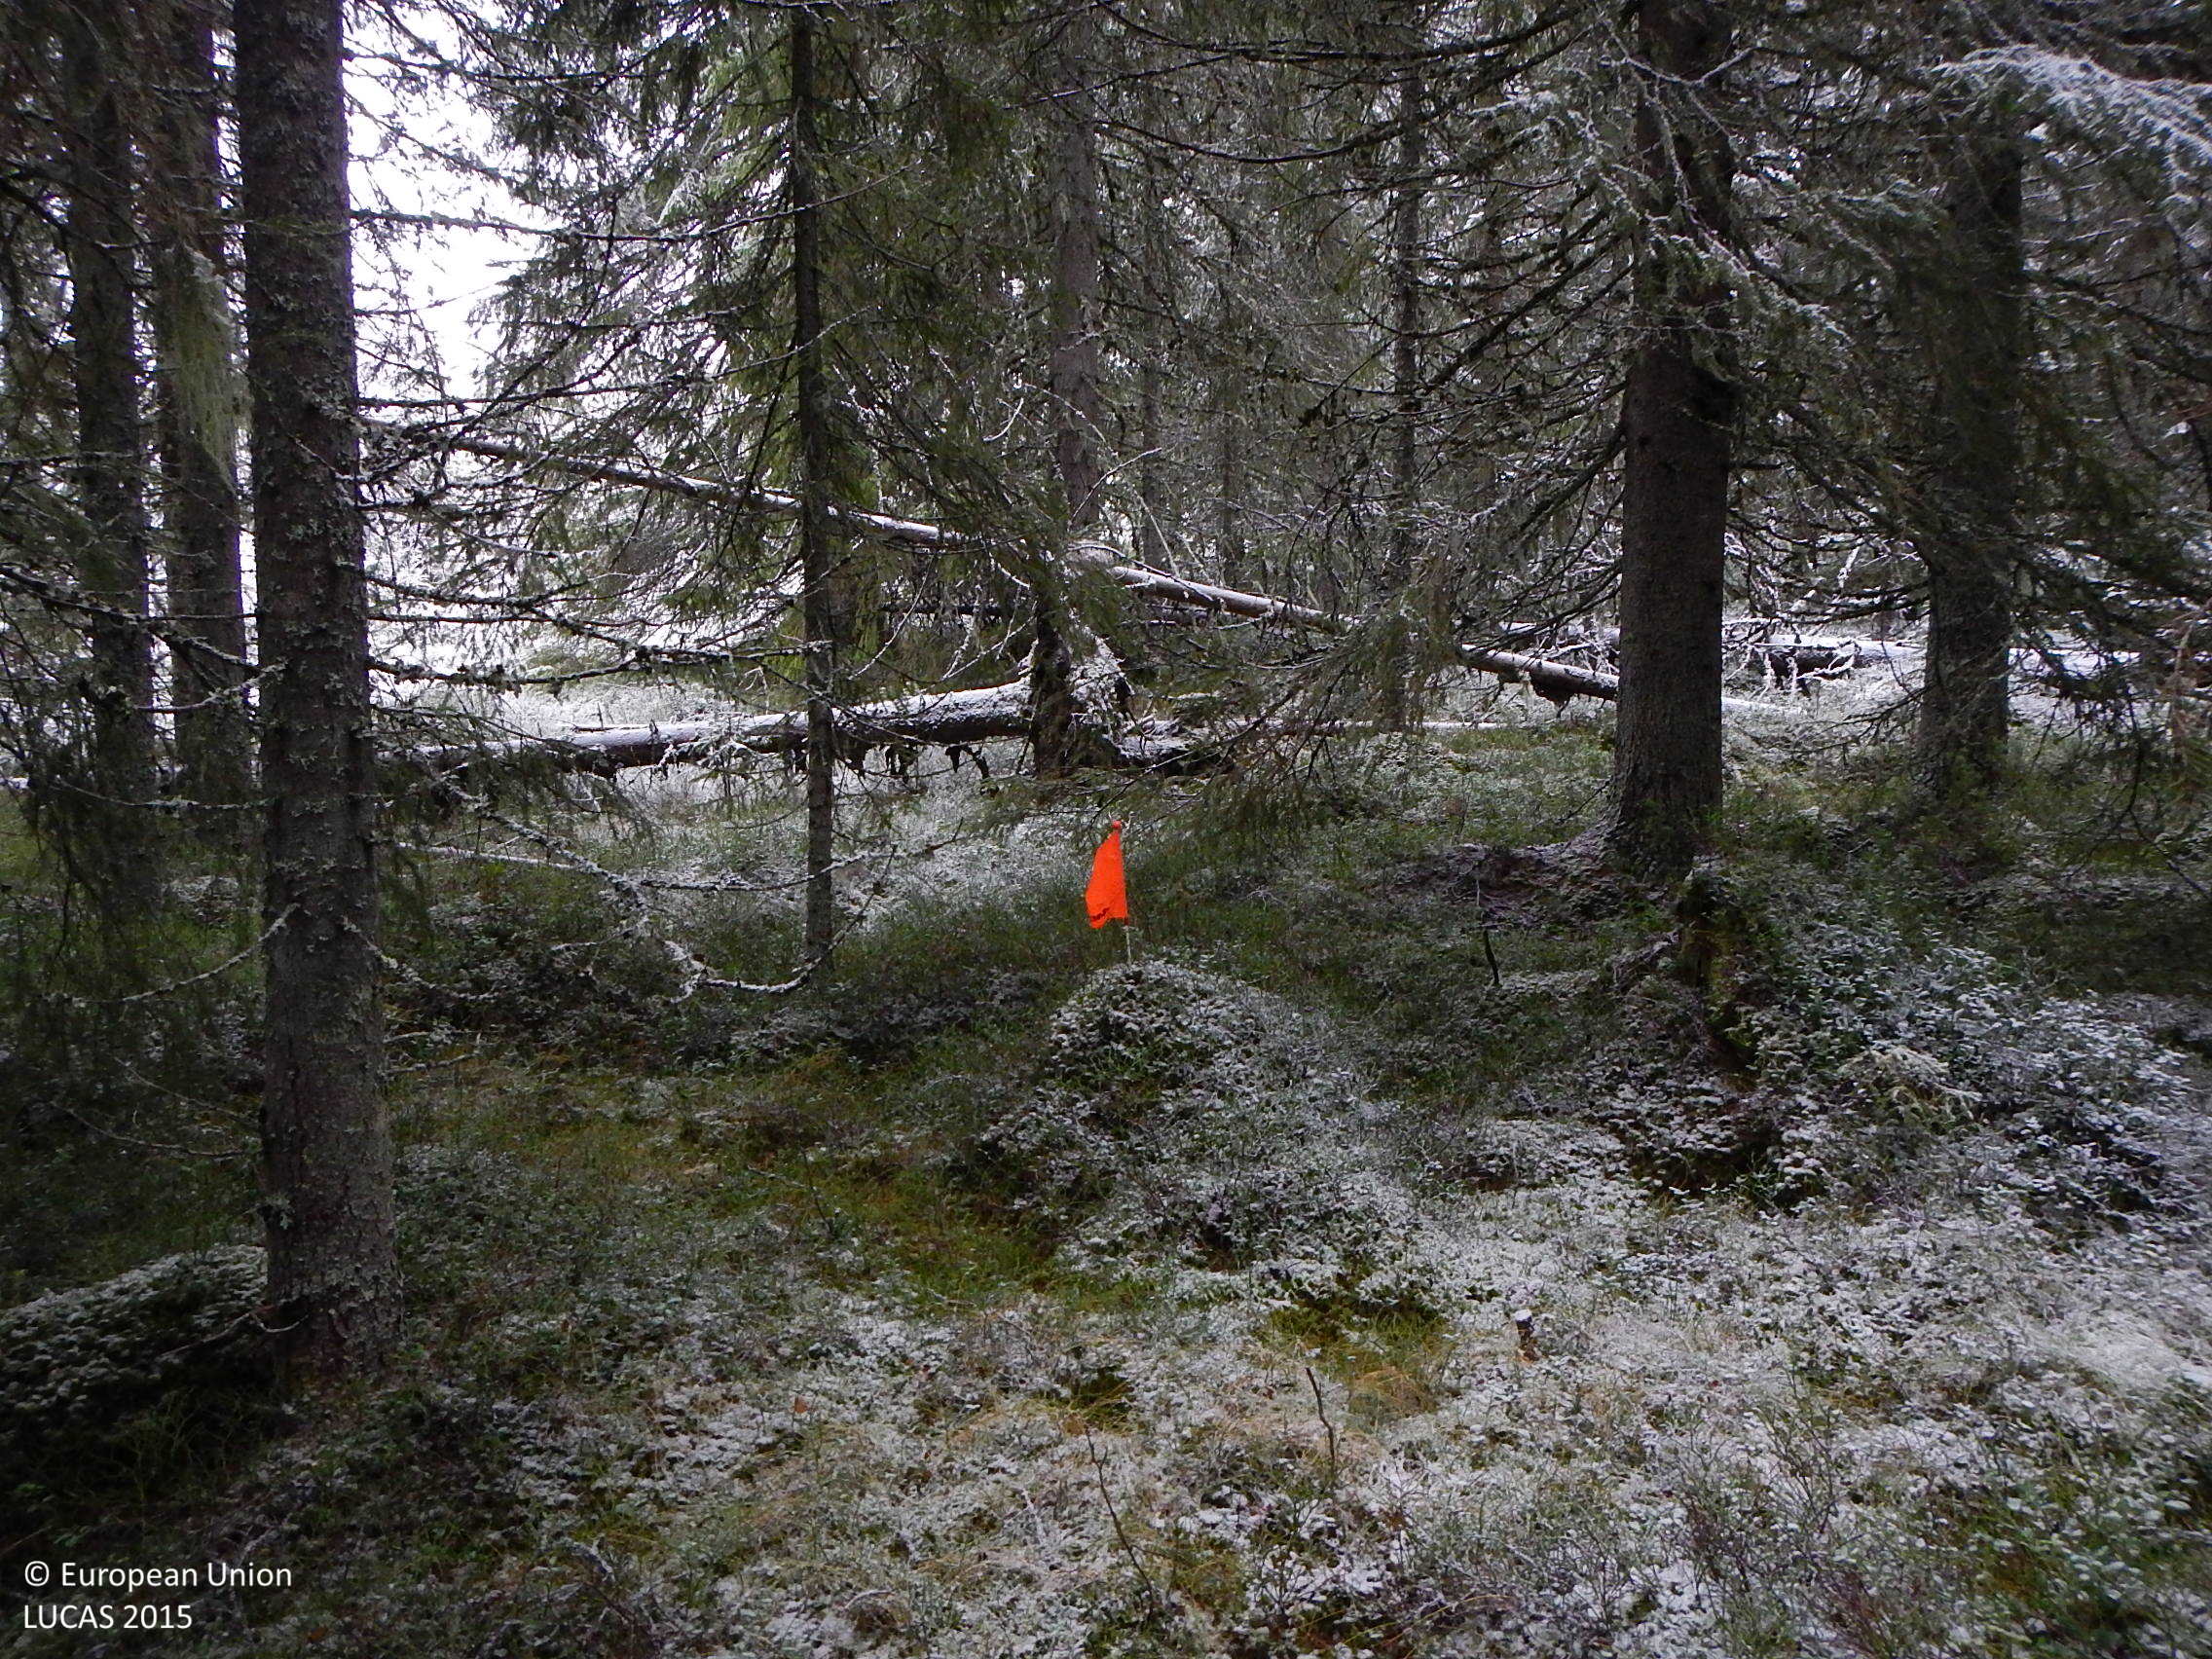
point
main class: Woodland
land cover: Spruce dominated coniferous woodland
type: boreal forest
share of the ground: > 75 %
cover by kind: coniferous forest trees 80 %, shrubs 10 %, lichens and mosses 10 %
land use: Forestry
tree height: > 5 m
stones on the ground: < 10 %
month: November
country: SE
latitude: 61.7904
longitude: 15.4633
